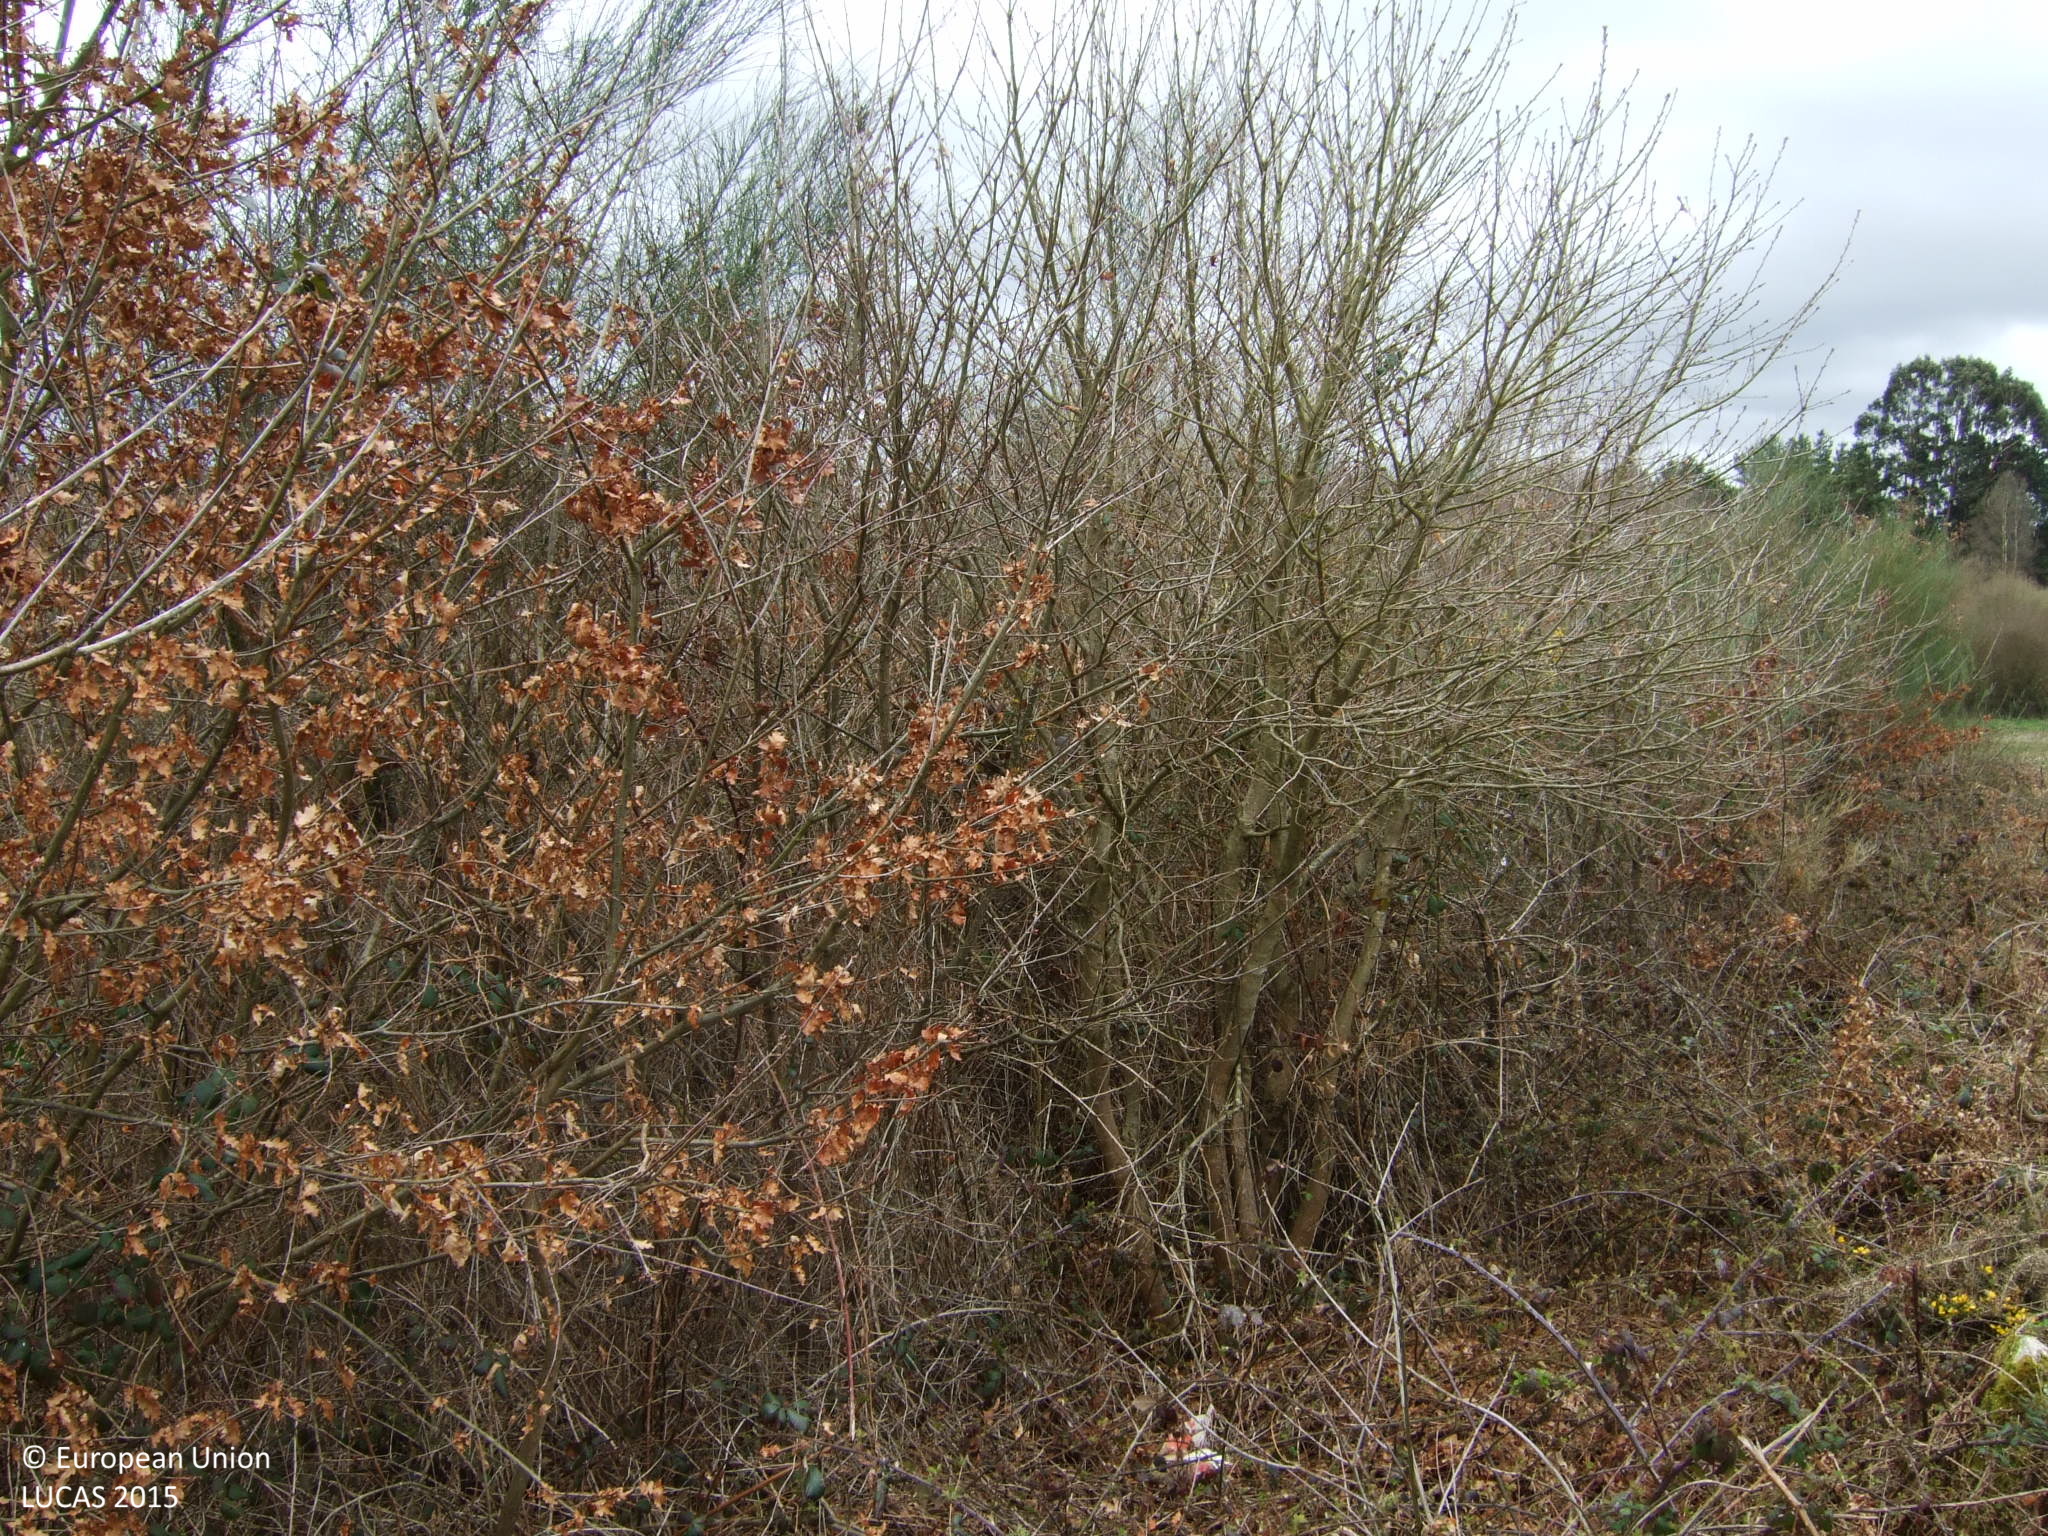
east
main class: Woodland
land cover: Broadleaved woodland
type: acidophilous oak and oak-birch forest
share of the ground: > 75 %
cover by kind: broadleaved forest trees 90 %, shrubs 10 %
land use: Semi-natural and natural areas not in use
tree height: > 5 m
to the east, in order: Broadleaved woodland; Shrubland with sparse tree cover; Electric lines; Shrubland with sparse tree cover; Broadleaved woodland; Pine dominated coniferous woodland; Broadleaved woodland
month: March
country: ES
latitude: 42.9789
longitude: -7.6012
